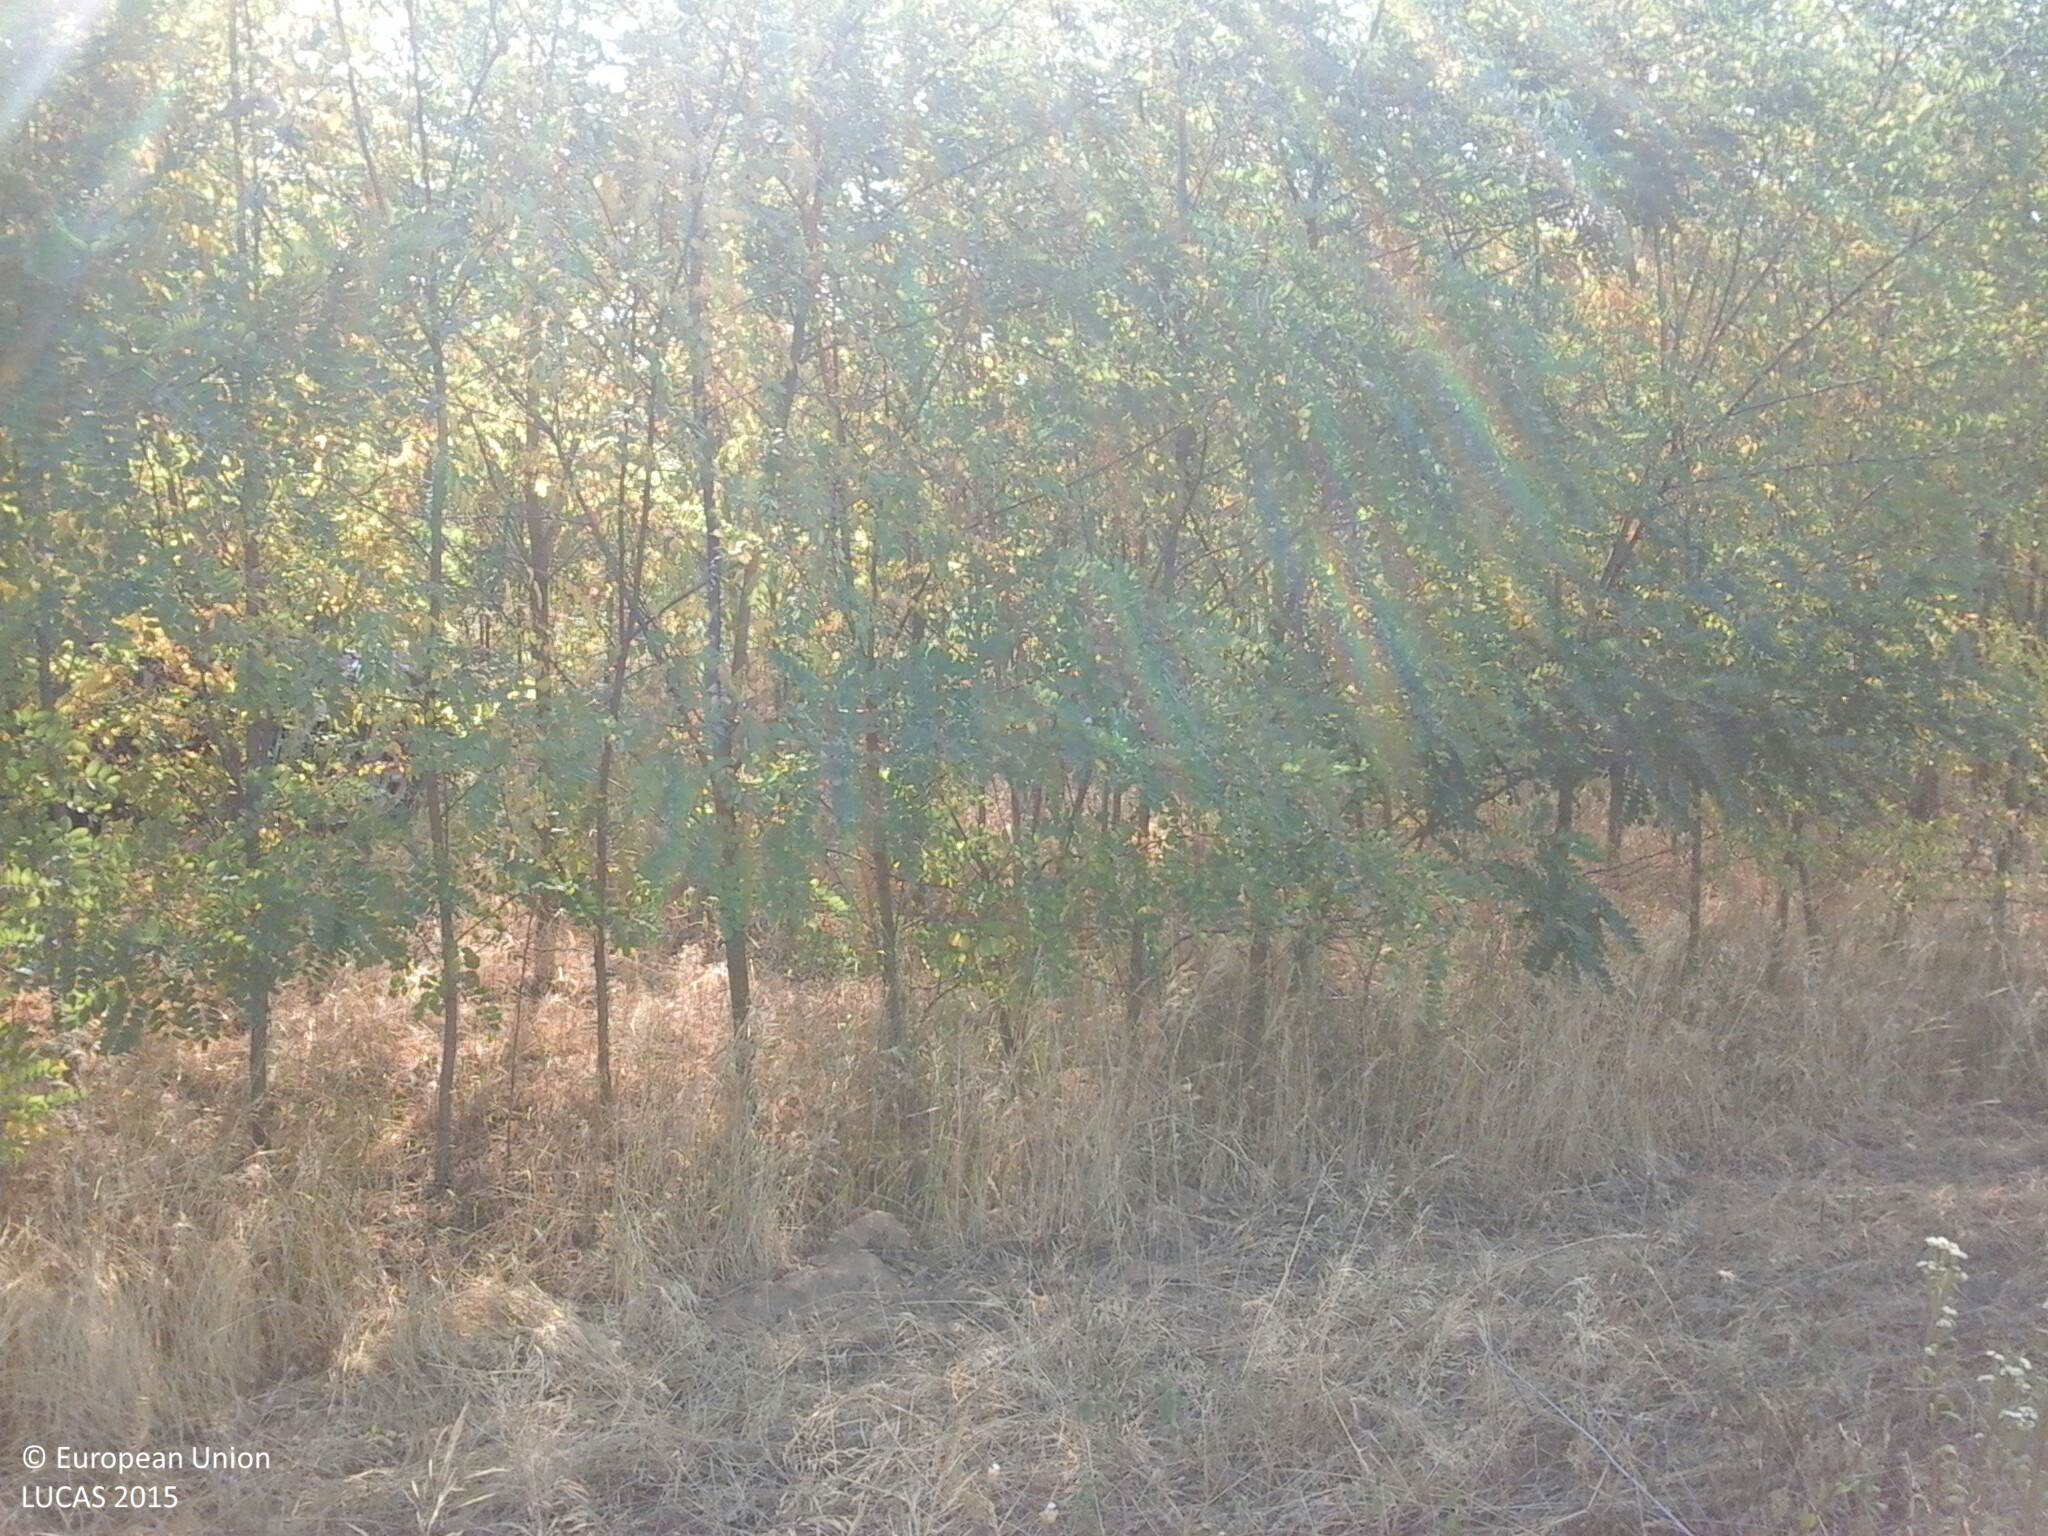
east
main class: Grassland
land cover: Grassland without tree/shrub cover
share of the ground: > 75 %
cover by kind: herbaceous plants 100 %
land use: Abandoned areas
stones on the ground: < 10 %
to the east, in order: Grassland without tree/shrub cover; Broadleaved woodland; Tracks; Broadleaved woodland; Apple fruit; Grassland without tree/shrub cover; Lines of trees; Apple fruit; Tracks; Broadleaved woodland
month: July
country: HU
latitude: 48.2389
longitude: 22.1602
